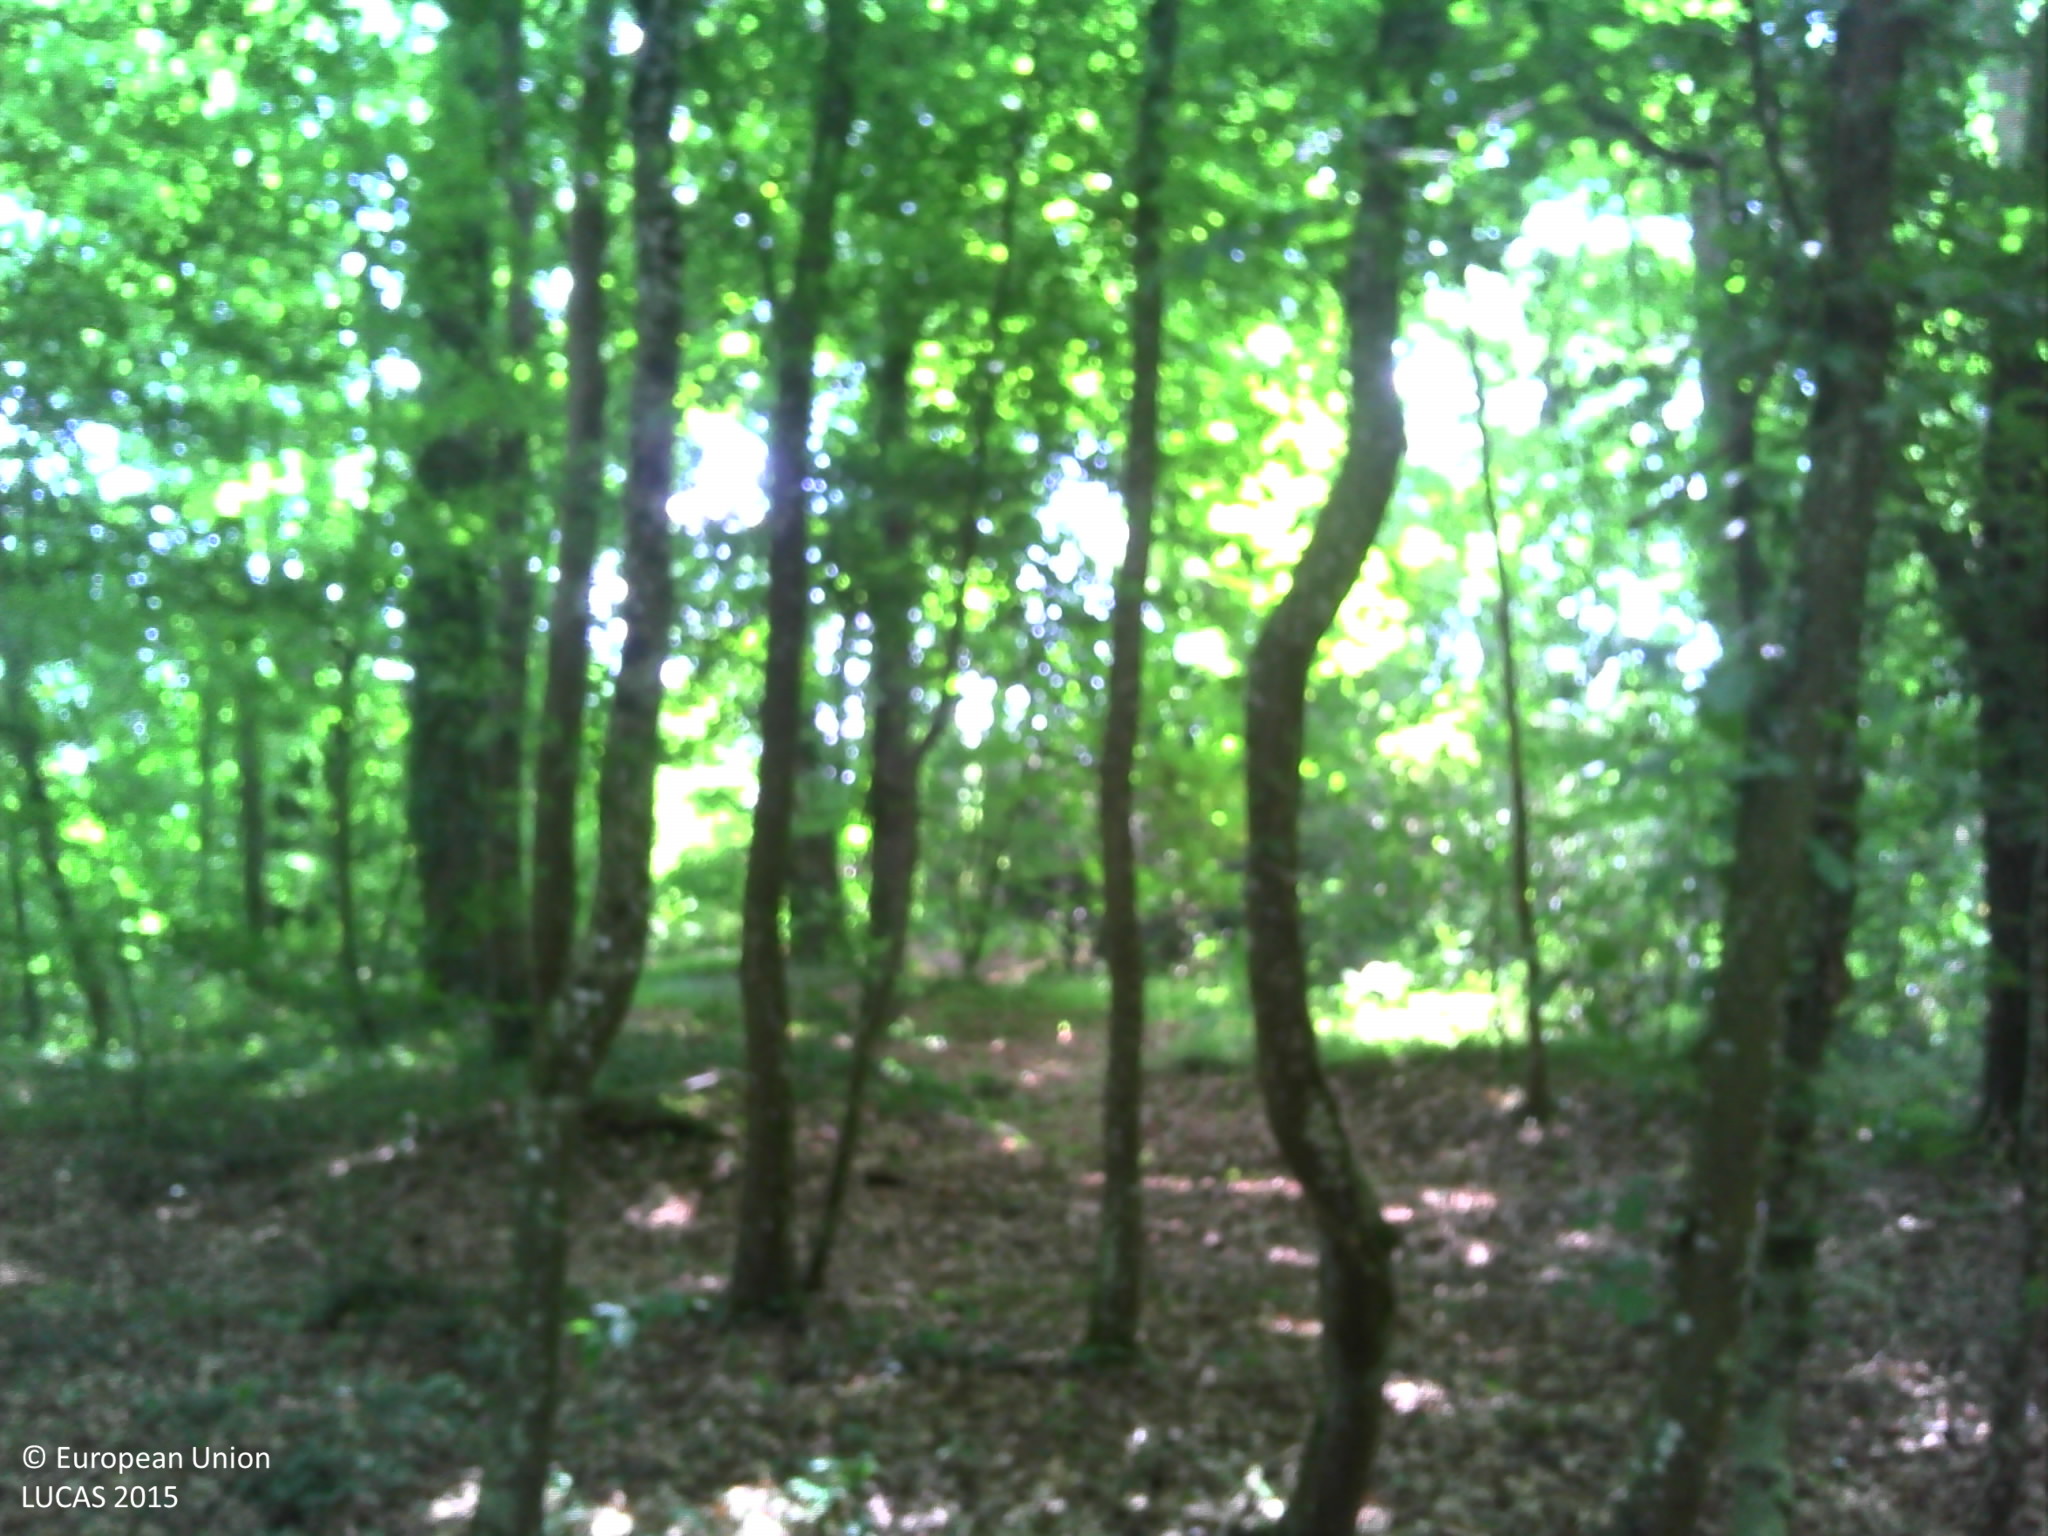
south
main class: Woodland
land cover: Broadleaved woodland
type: mesophytic deciduous forest
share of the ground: > 75 %
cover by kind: broadleaved forest trees 55 %, lichens and mosses 20 %, coniferous forest trees 15 %, herbaceous plants 10 %
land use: Forestry
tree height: > 5 m
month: June
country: FR
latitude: 47.7909
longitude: 0.0551
